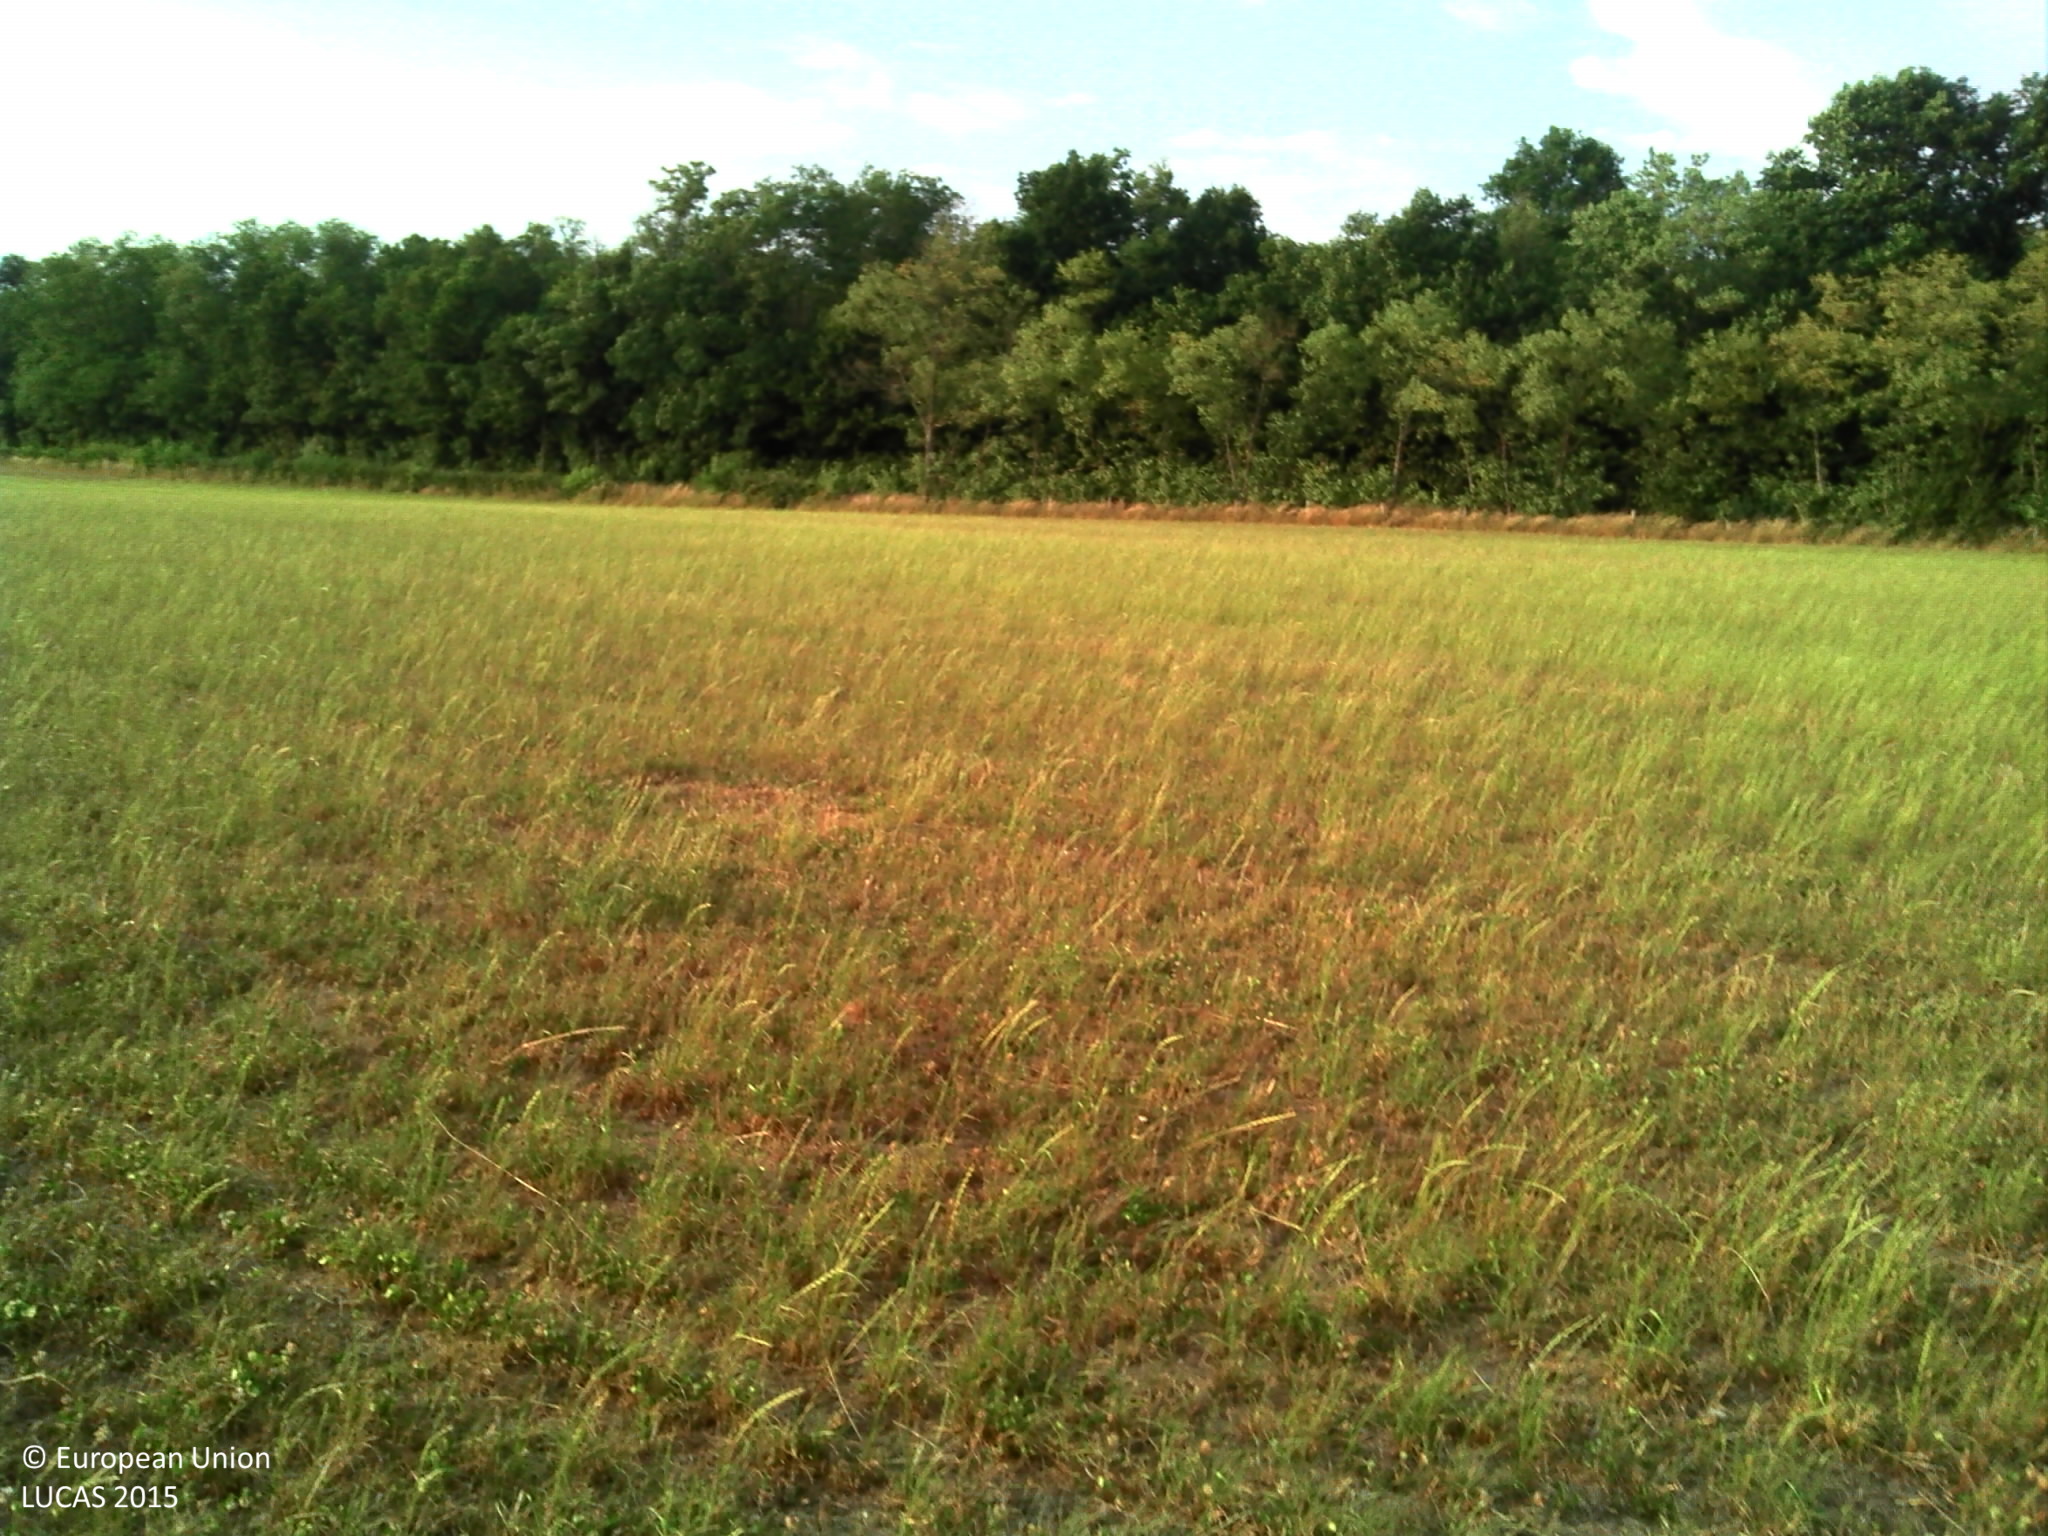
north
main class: Cropland
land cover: Temporary grasslands
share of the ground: > 75 %
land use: Agriculture (excluding fallow land and kitchen gardens)
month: July
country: FR
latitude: 46.7538
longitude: 3.5706
